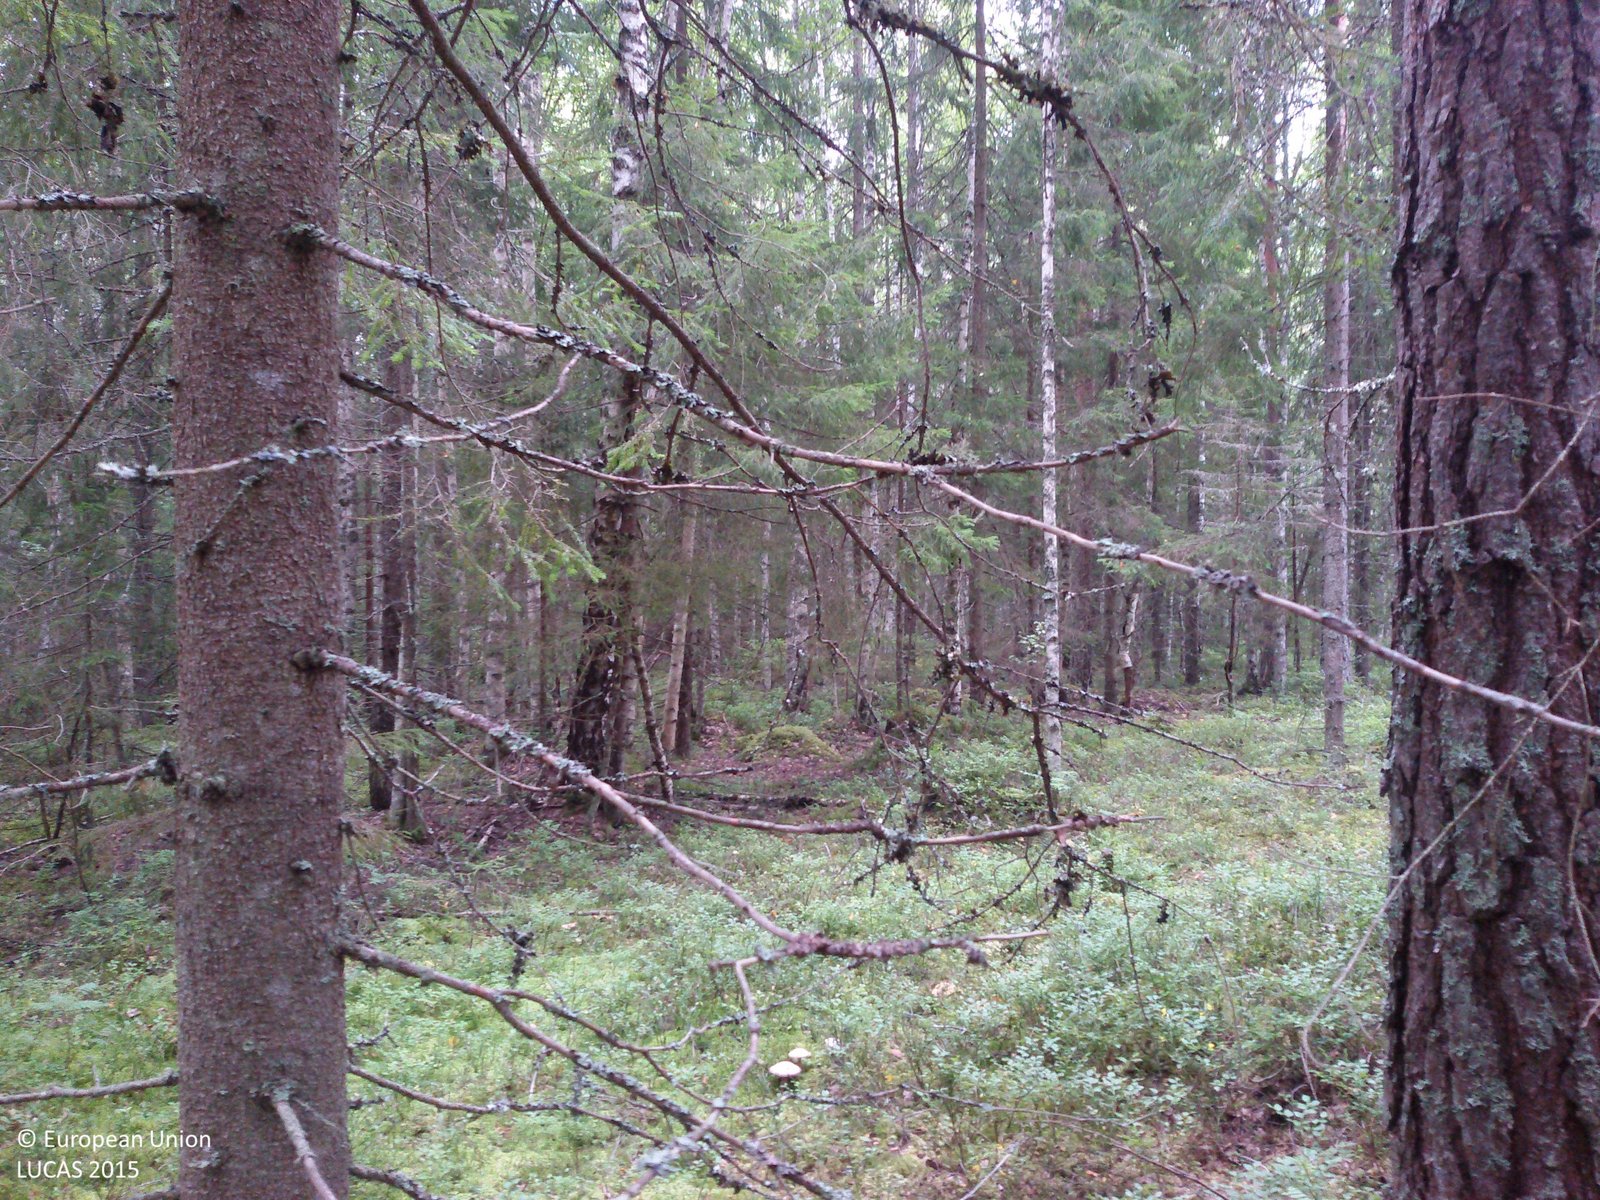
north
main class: Woodland
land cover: Spruce dominated mixed woodland
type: boreal forest
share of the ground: > 75 %
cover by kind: coniferous forest trees 55 %, broadleaved forest trees 30 %, lichens and mosses 10 %, herbaceous plants 5 %
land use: Forestry
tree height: > 5 m
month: August
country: SE
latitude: 60.6574
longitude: 16.6289
